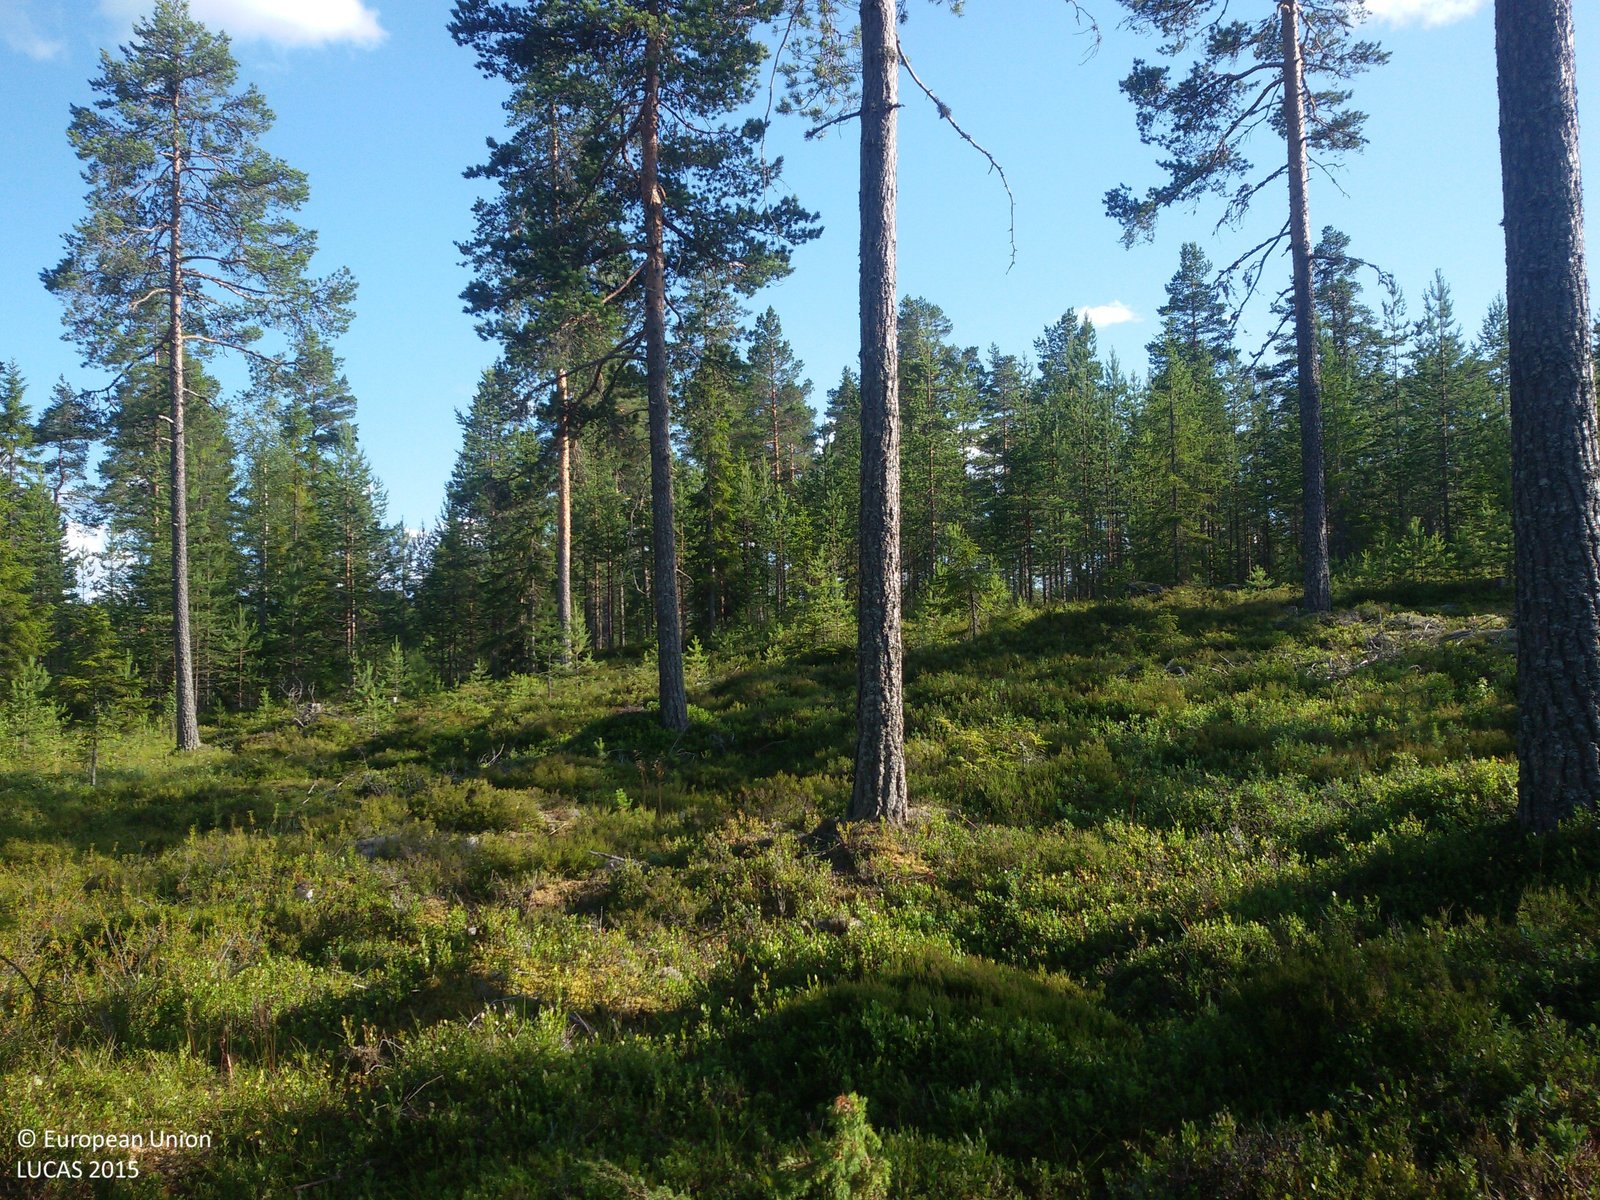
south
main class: Woodland
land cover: Pine dominated coniferous woodland
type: boreal forest
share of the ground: 50 - 75 %
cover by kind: coniferous forest trees 50 %, herbaceous plants 50 %
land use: Forestry
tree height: > 5 m
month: July
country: SE
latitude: 60.6762
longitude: 15.3138
